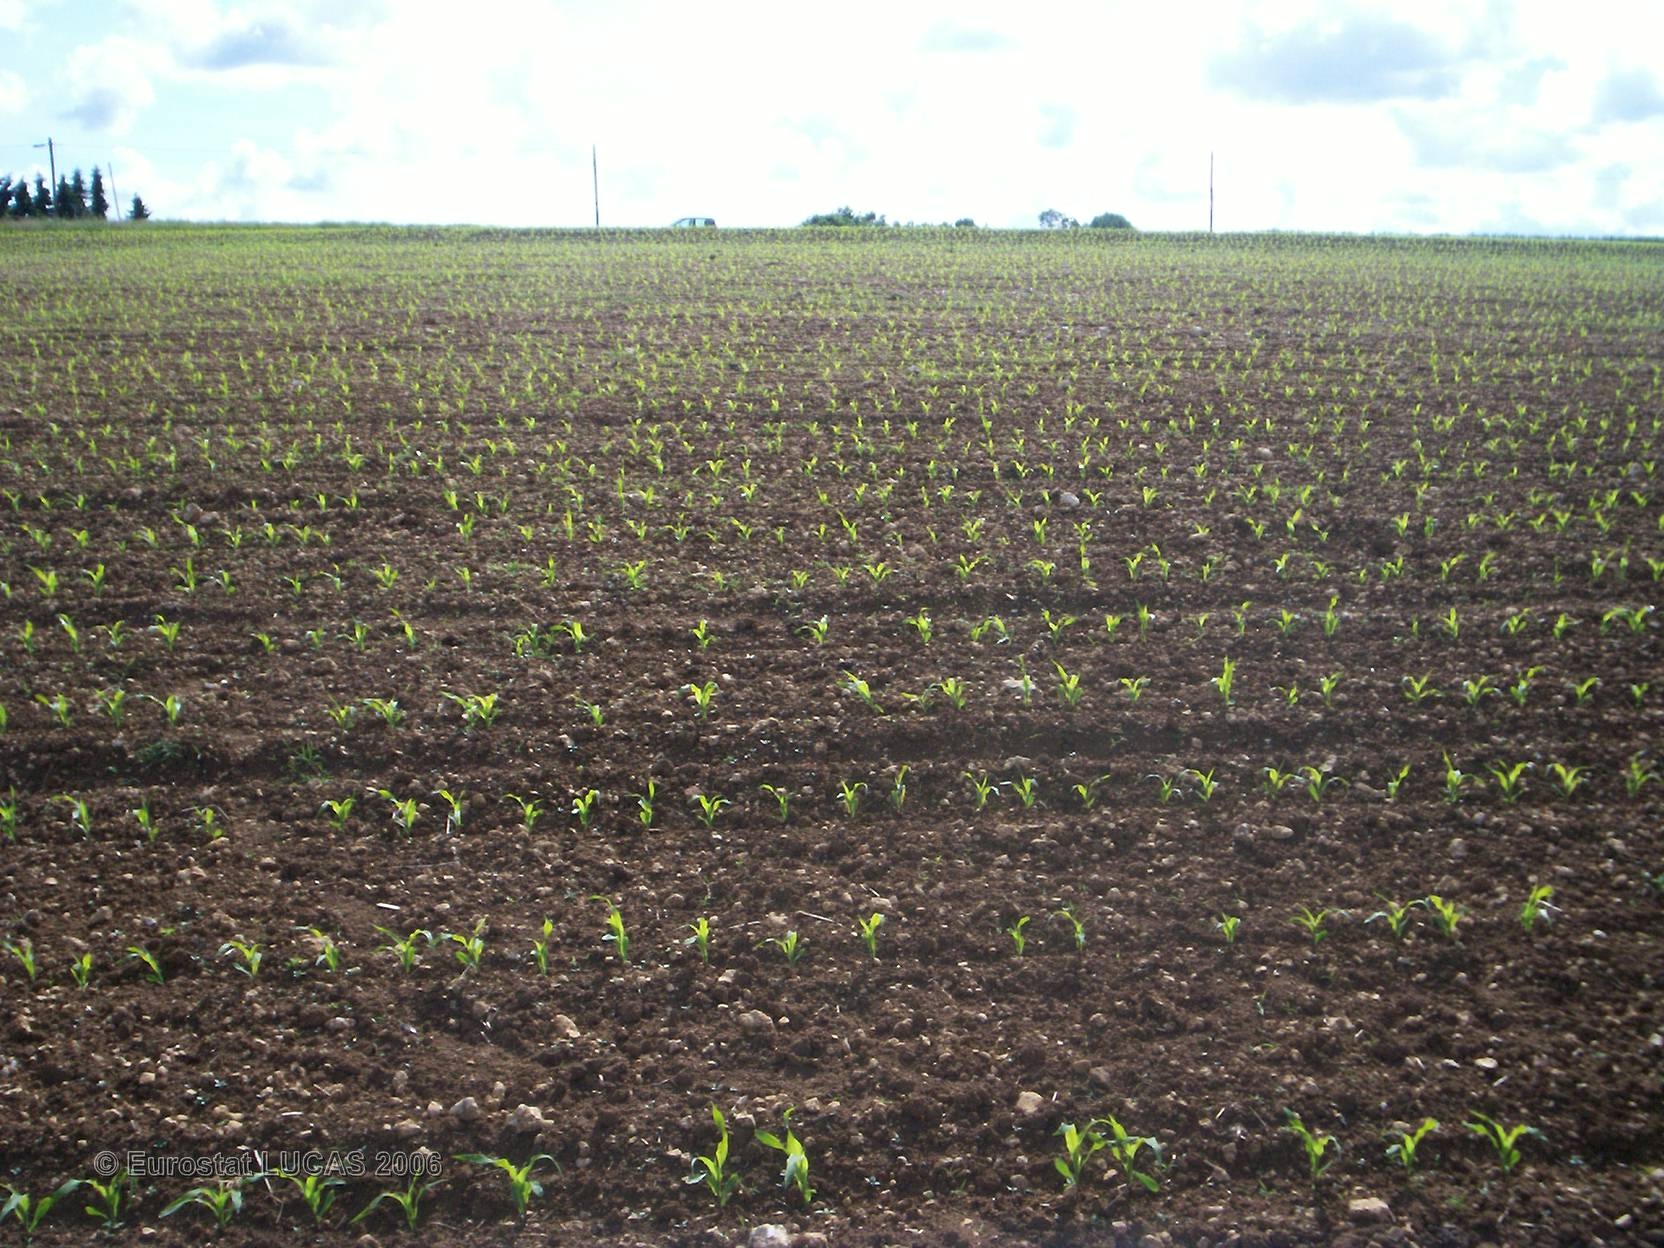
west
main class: Cropland
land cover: Maize
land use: Agriculture (excluding fallow land and kitchen gardens)
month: May
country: FR
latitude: 45.6963
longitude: -0.7744
